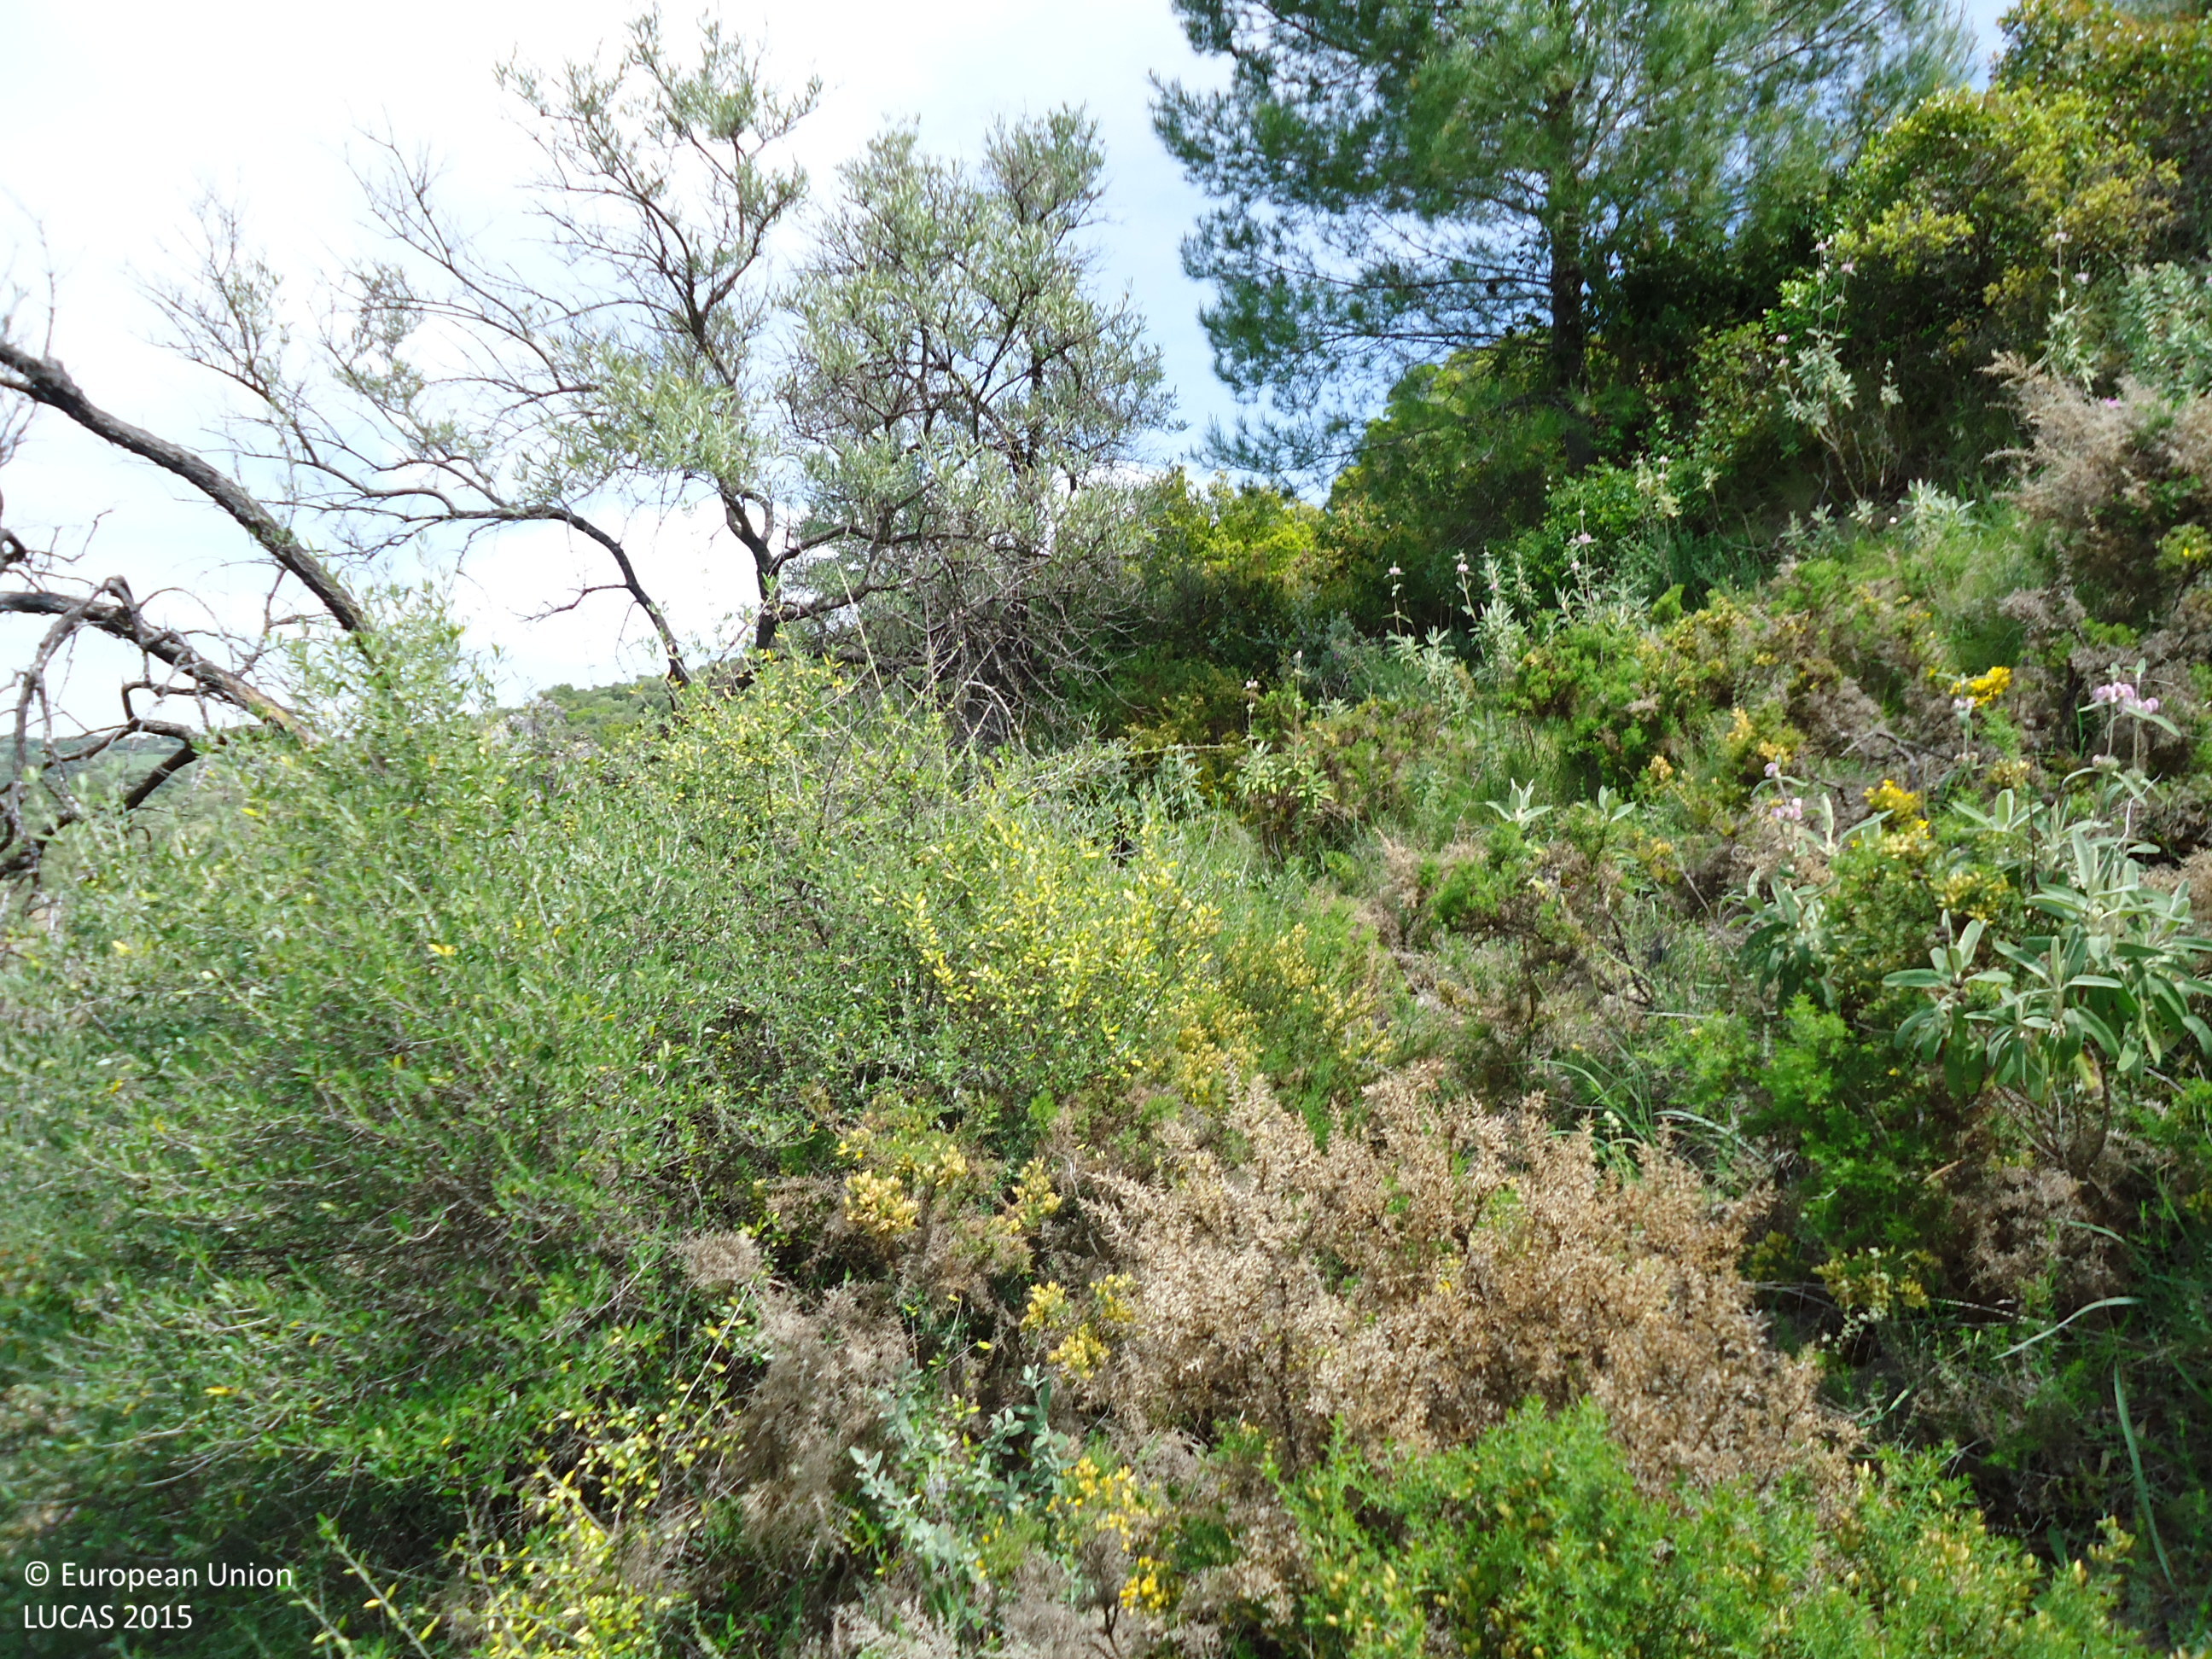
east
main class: Shrubland
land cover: Shrubland with sparse tree cover
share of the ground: > 75 %
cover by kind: shrubs 85 %, herbaceous plants 10 %, coniferous forest trees 5 %
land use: Semi-natural and natural areas not in use
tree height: > 5 m
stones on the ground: > 50 %
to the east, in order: Shrubland with sparse tree cover; Rock outcrops; Shrubland with sparse tree cover; Permanent crops (only in case pi)
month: April
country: ES
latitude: 36.9025
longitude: -5.4372
